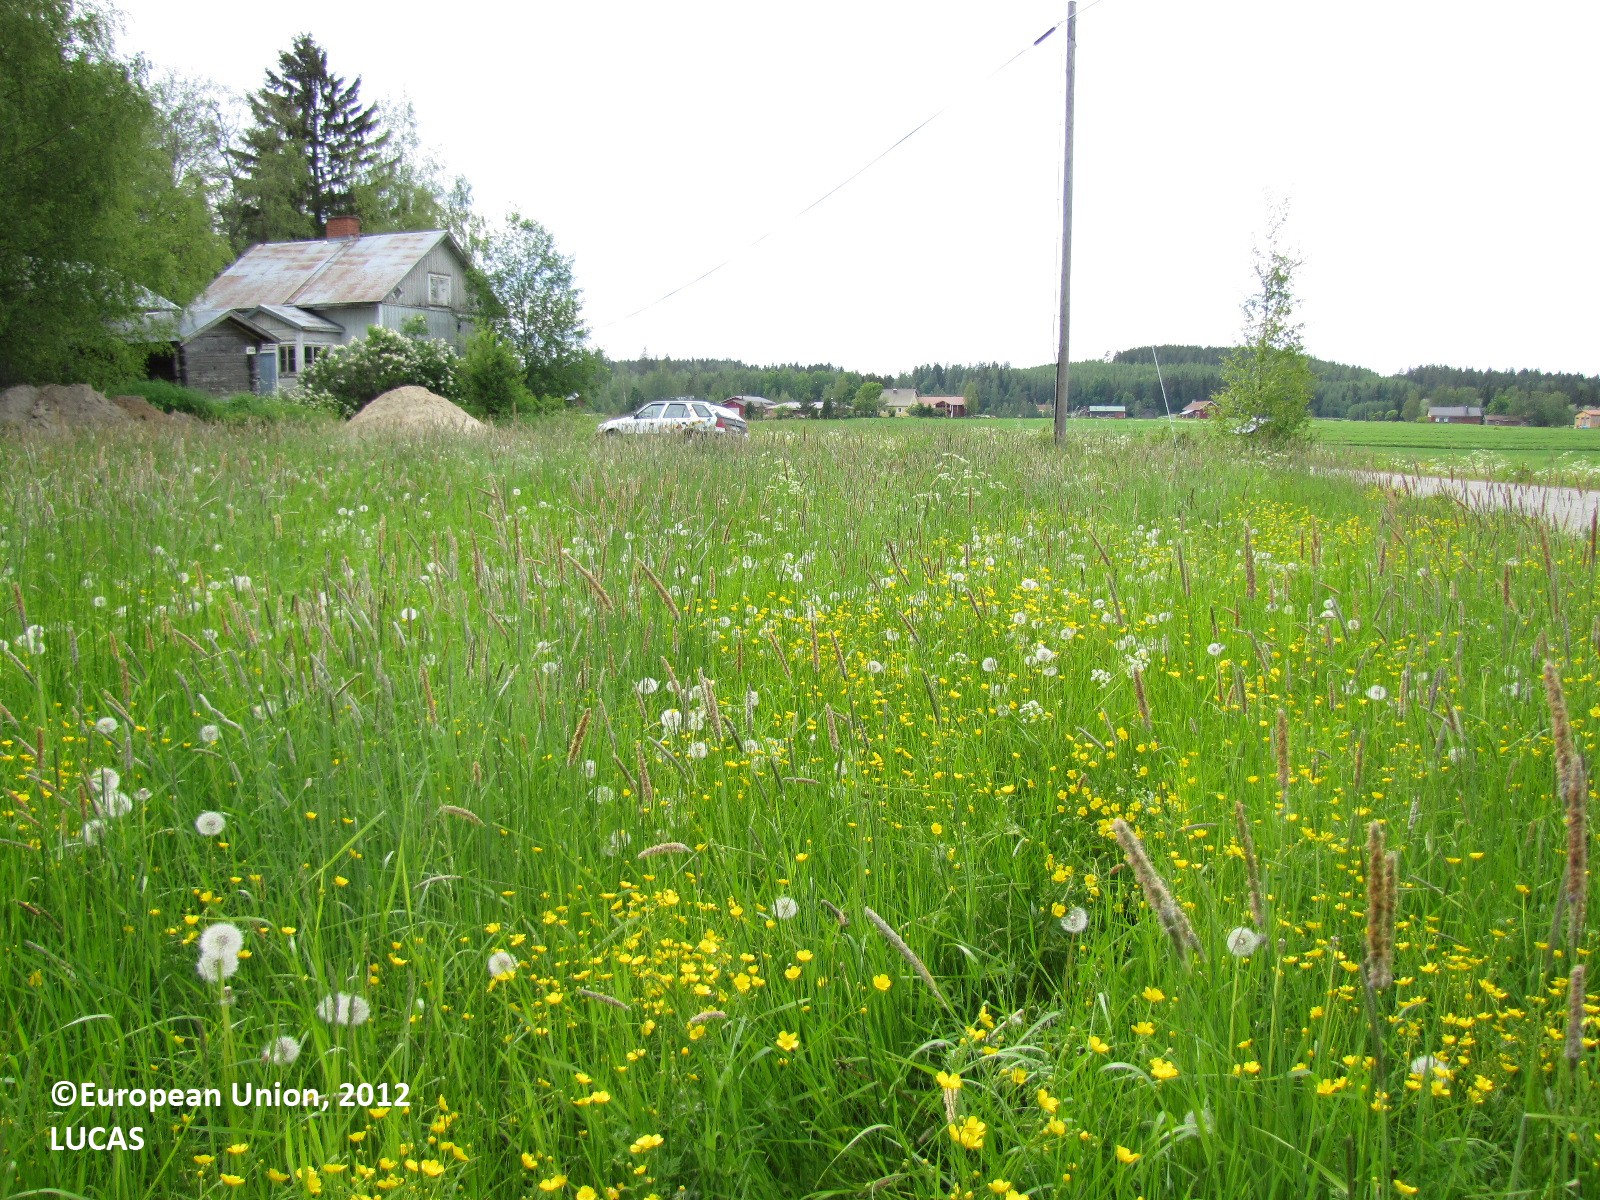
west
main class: Grassland
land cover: Grassland without tree/shrub cover
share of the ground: > 75 %
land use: Residential
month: June
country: FI
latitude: 61.4830
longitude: 24.3086
